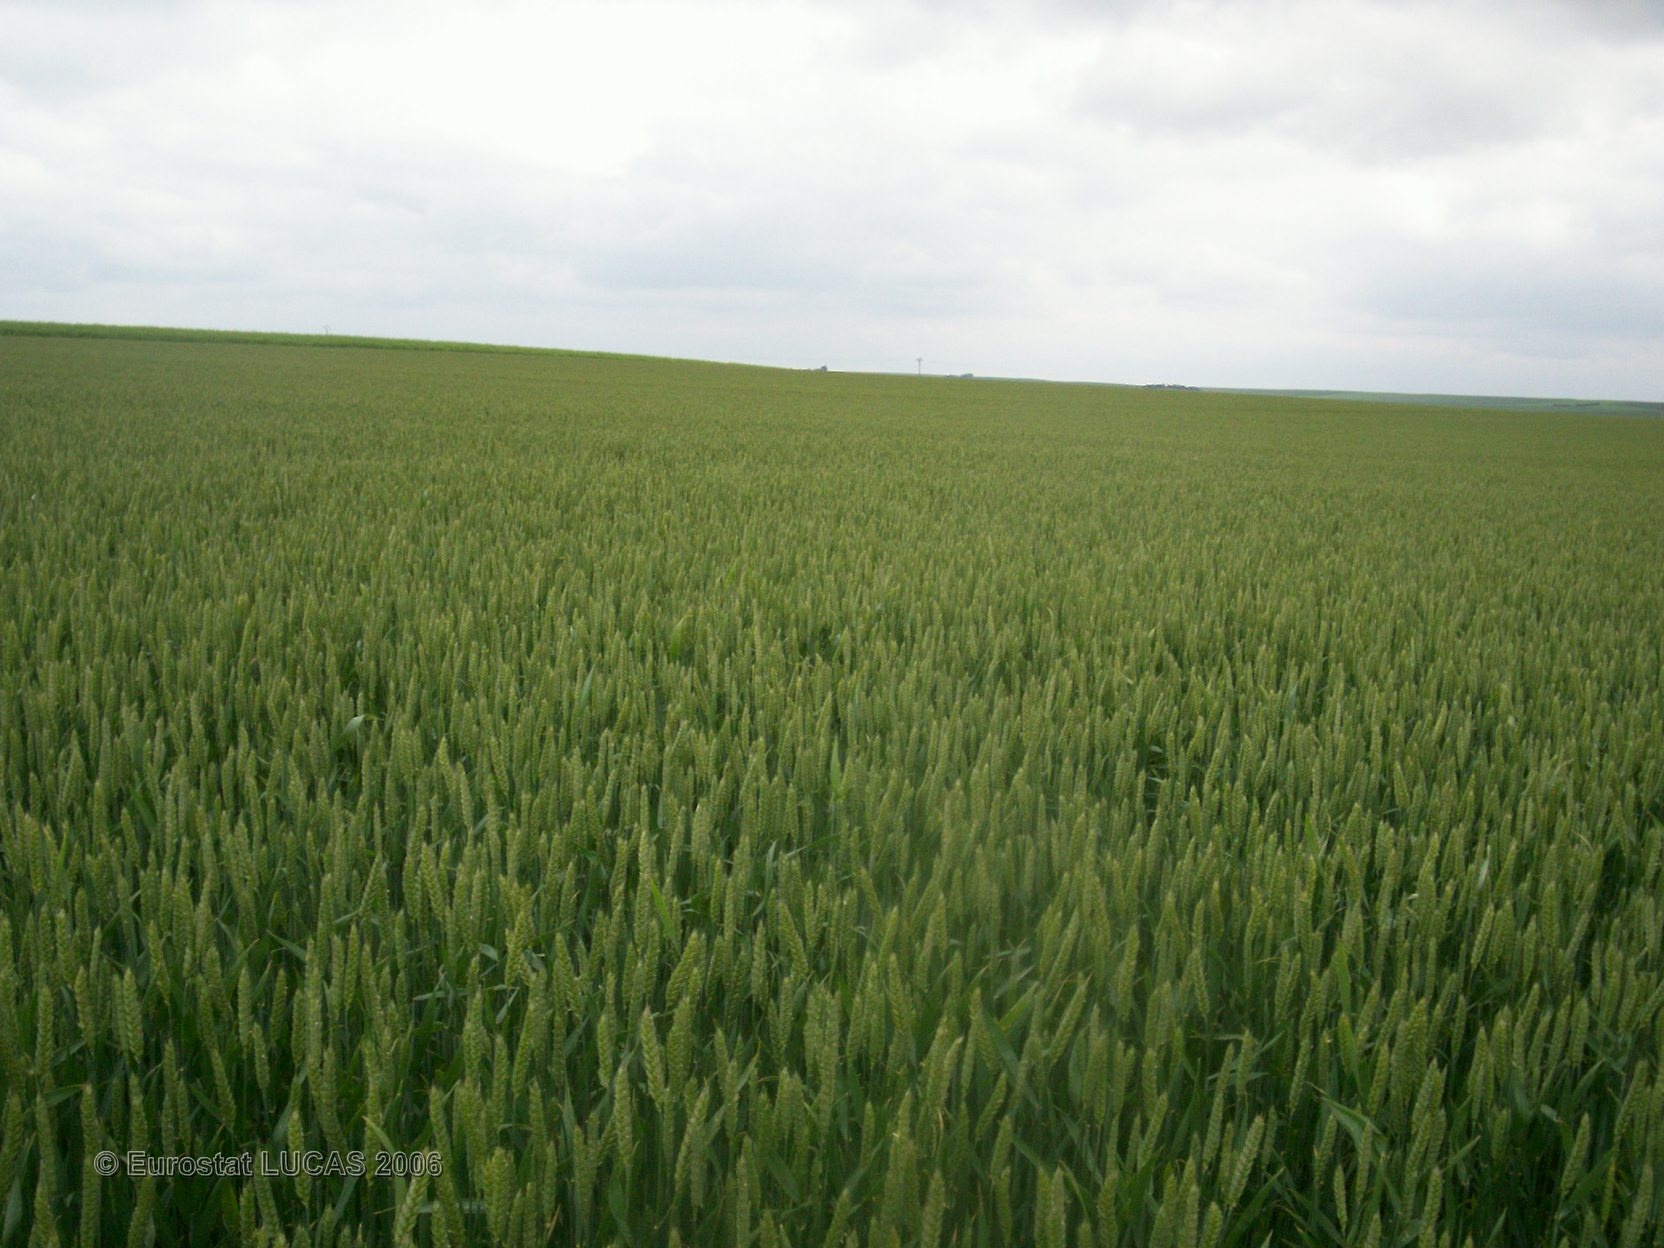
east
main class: Cropland
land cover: Common wheat
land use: Agriculture (excluding fallow land and kitchen gardens)
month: June
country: FR
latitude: 48.5875
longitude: 4.4250
